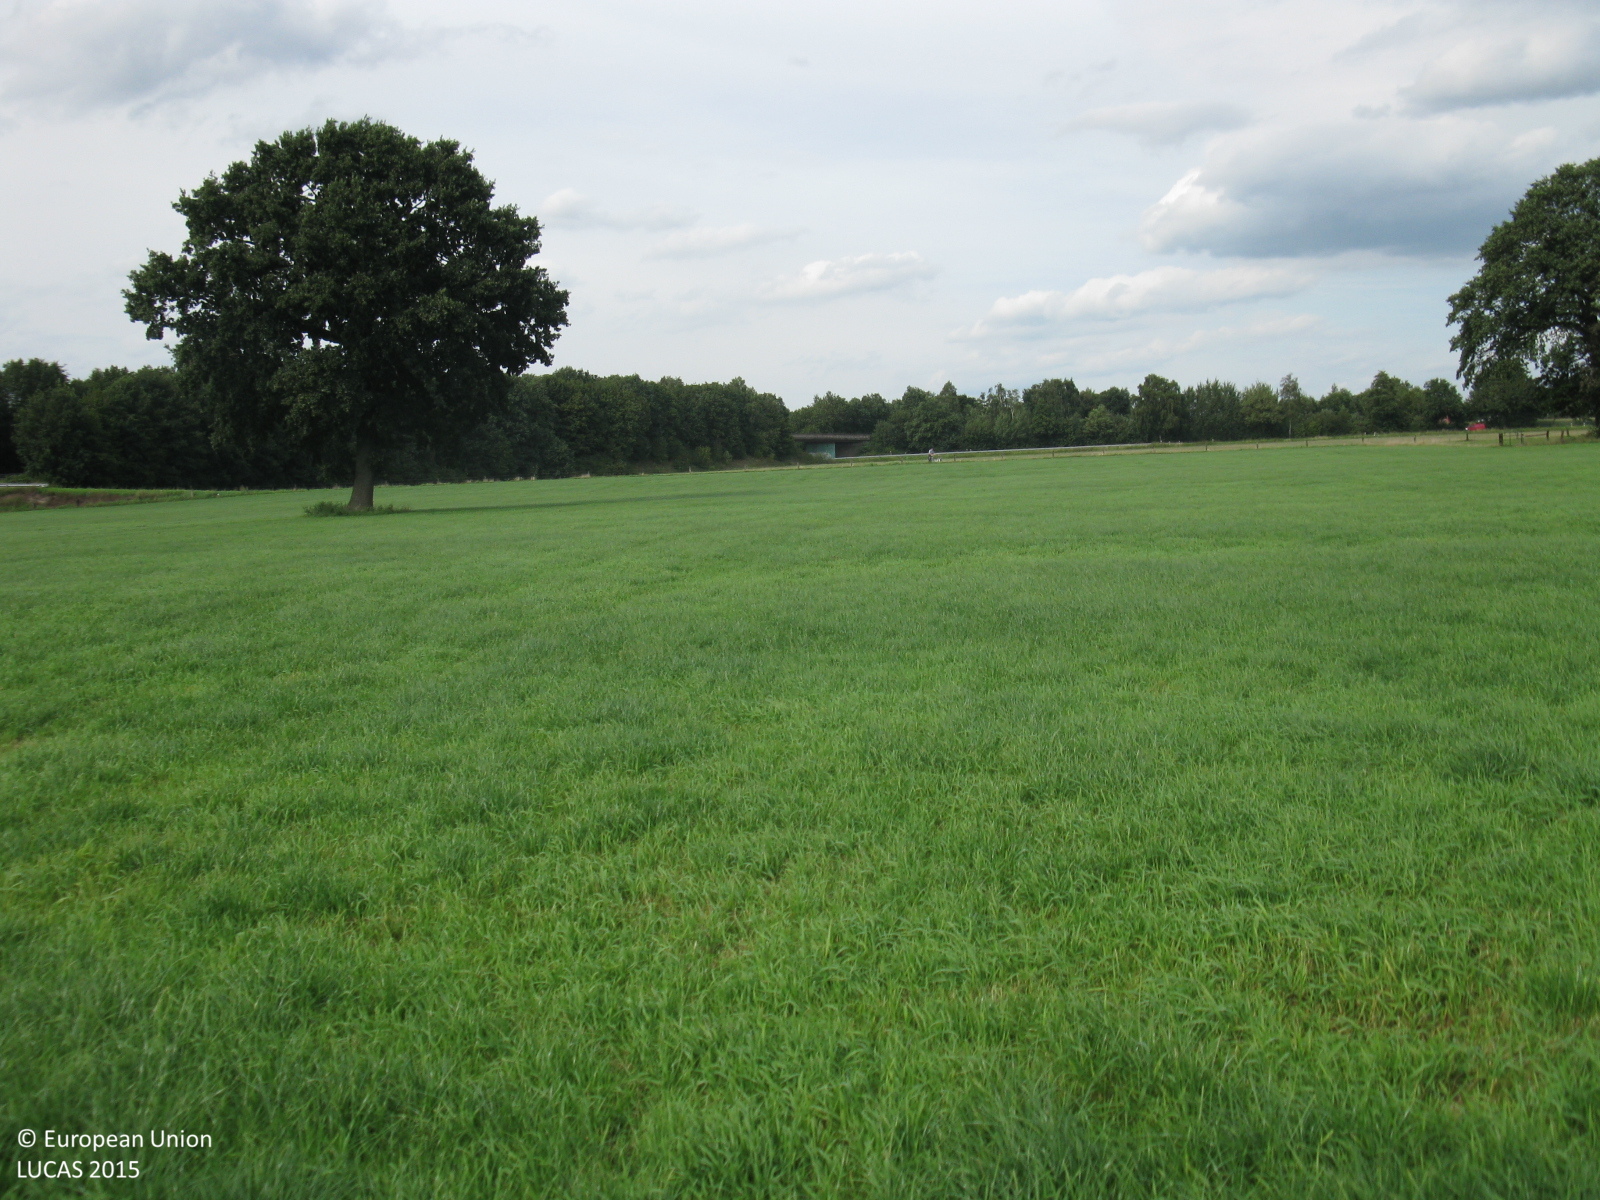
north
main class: Grassland
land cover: Grassland without tree/shrub cover
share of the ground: > 75 %
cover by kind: herbaceous plants 100 %
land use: Agriculture (excluding fallow land and kitchen gardens)
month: August
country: DE
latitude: 51.8164
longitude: 6.9391
